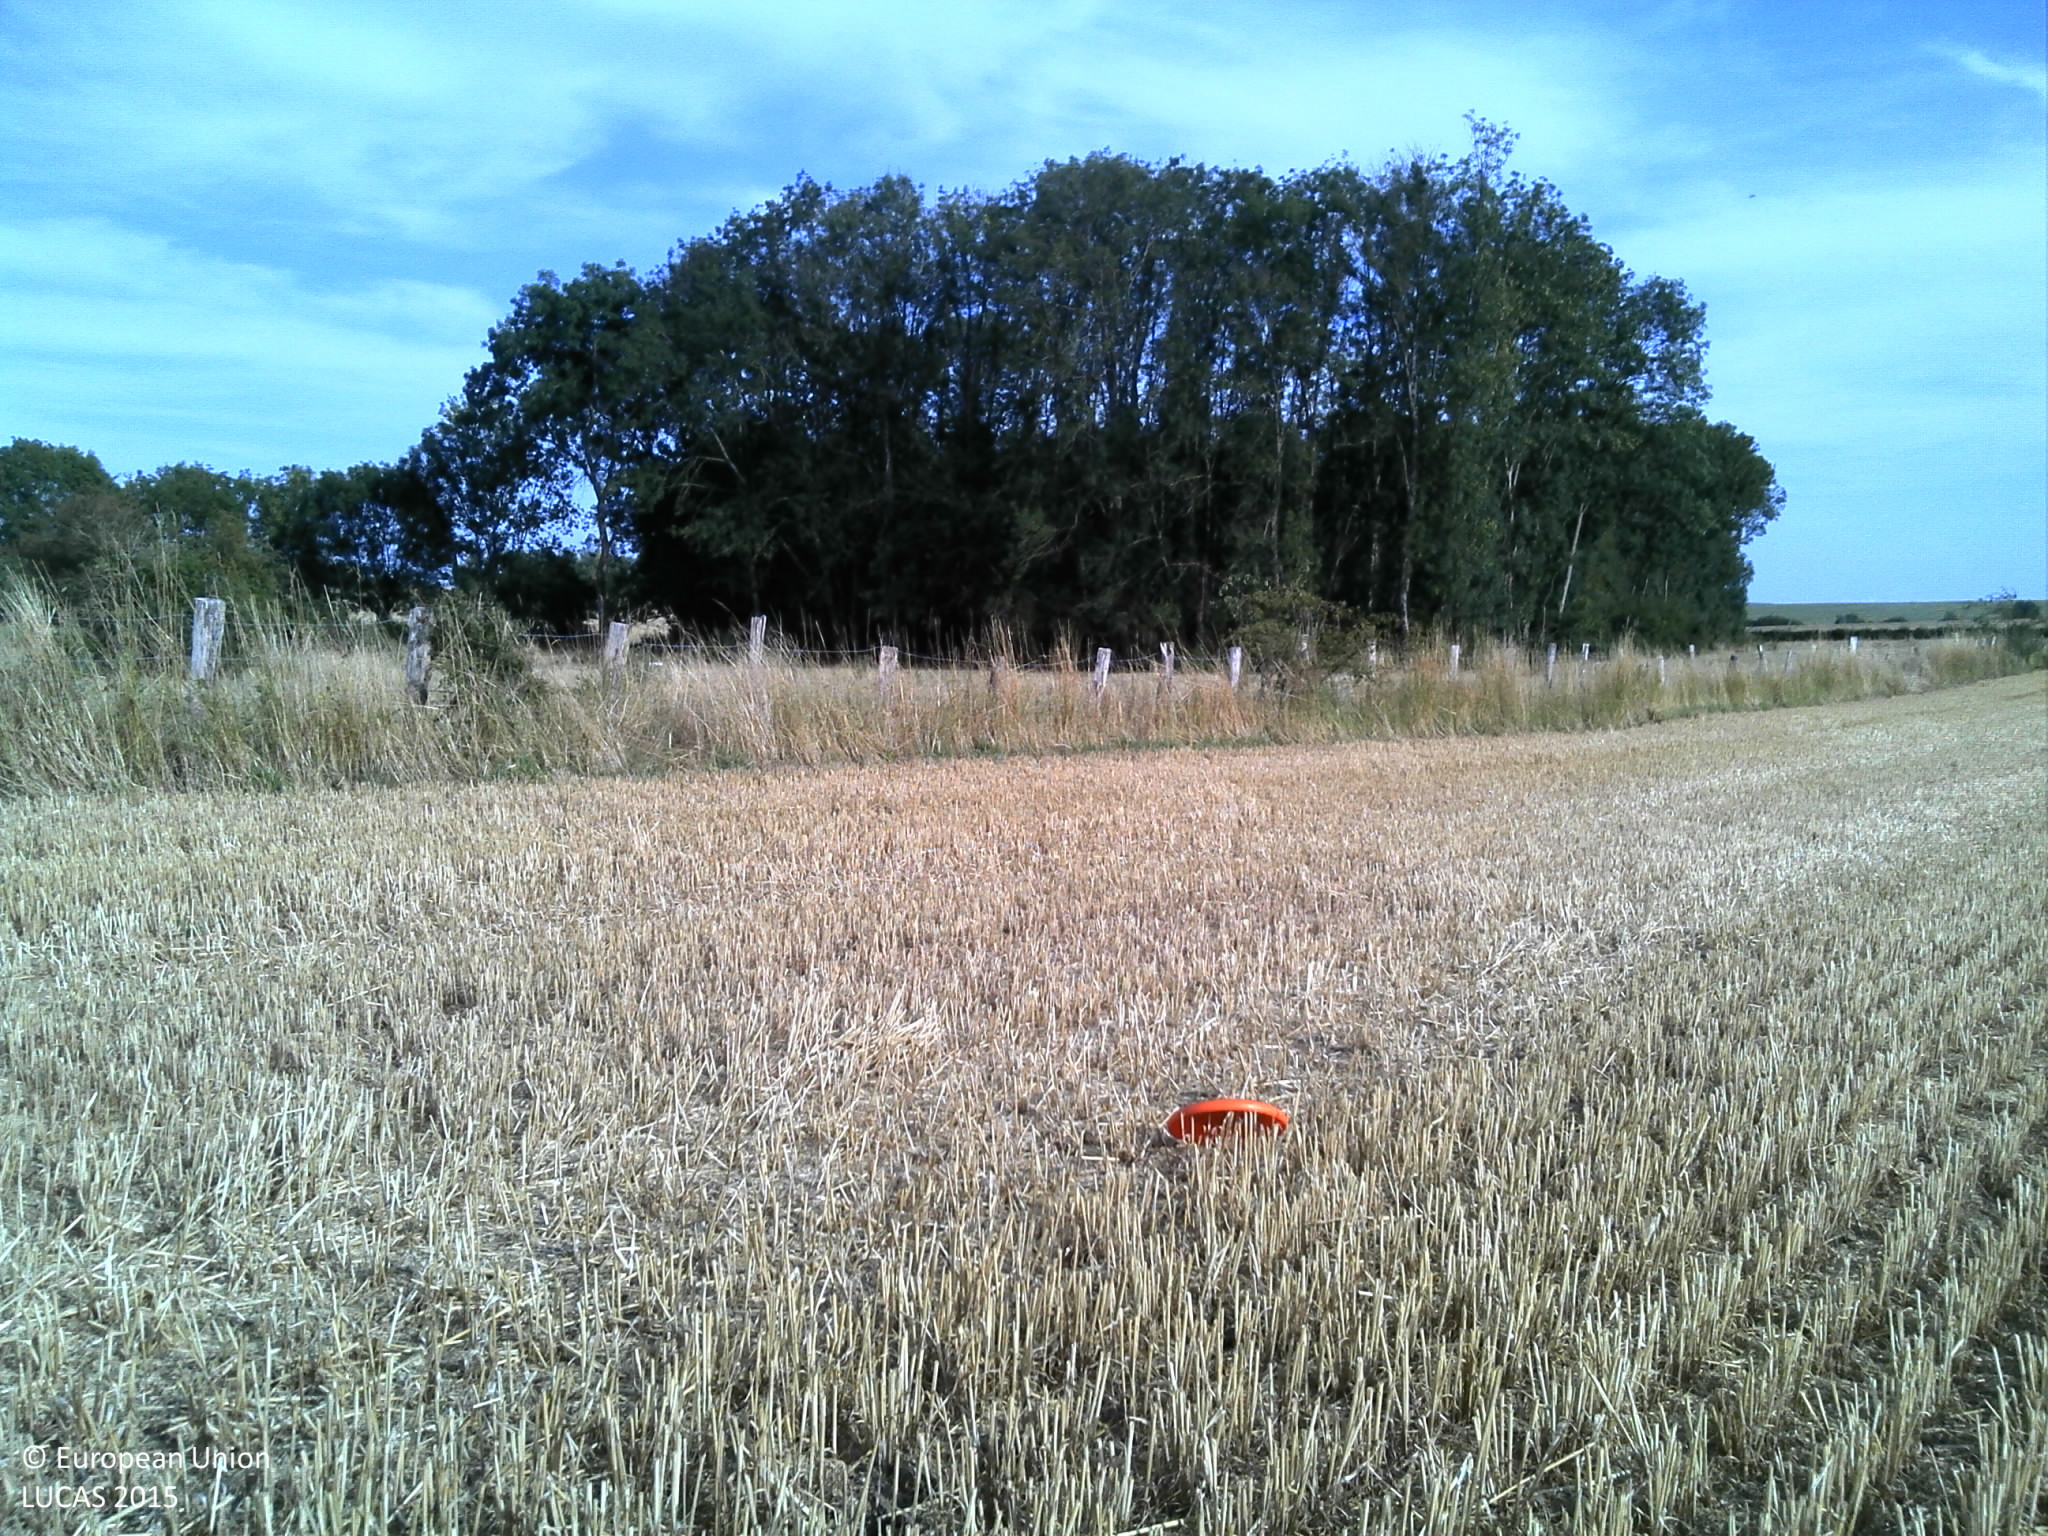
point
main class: Cropland
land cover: Common wheat
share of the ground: > 75 %
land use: Agriculture (excluding fallow land and kitchen gardens)
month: August
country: FR
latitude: 48.9493
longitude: 4.8223
